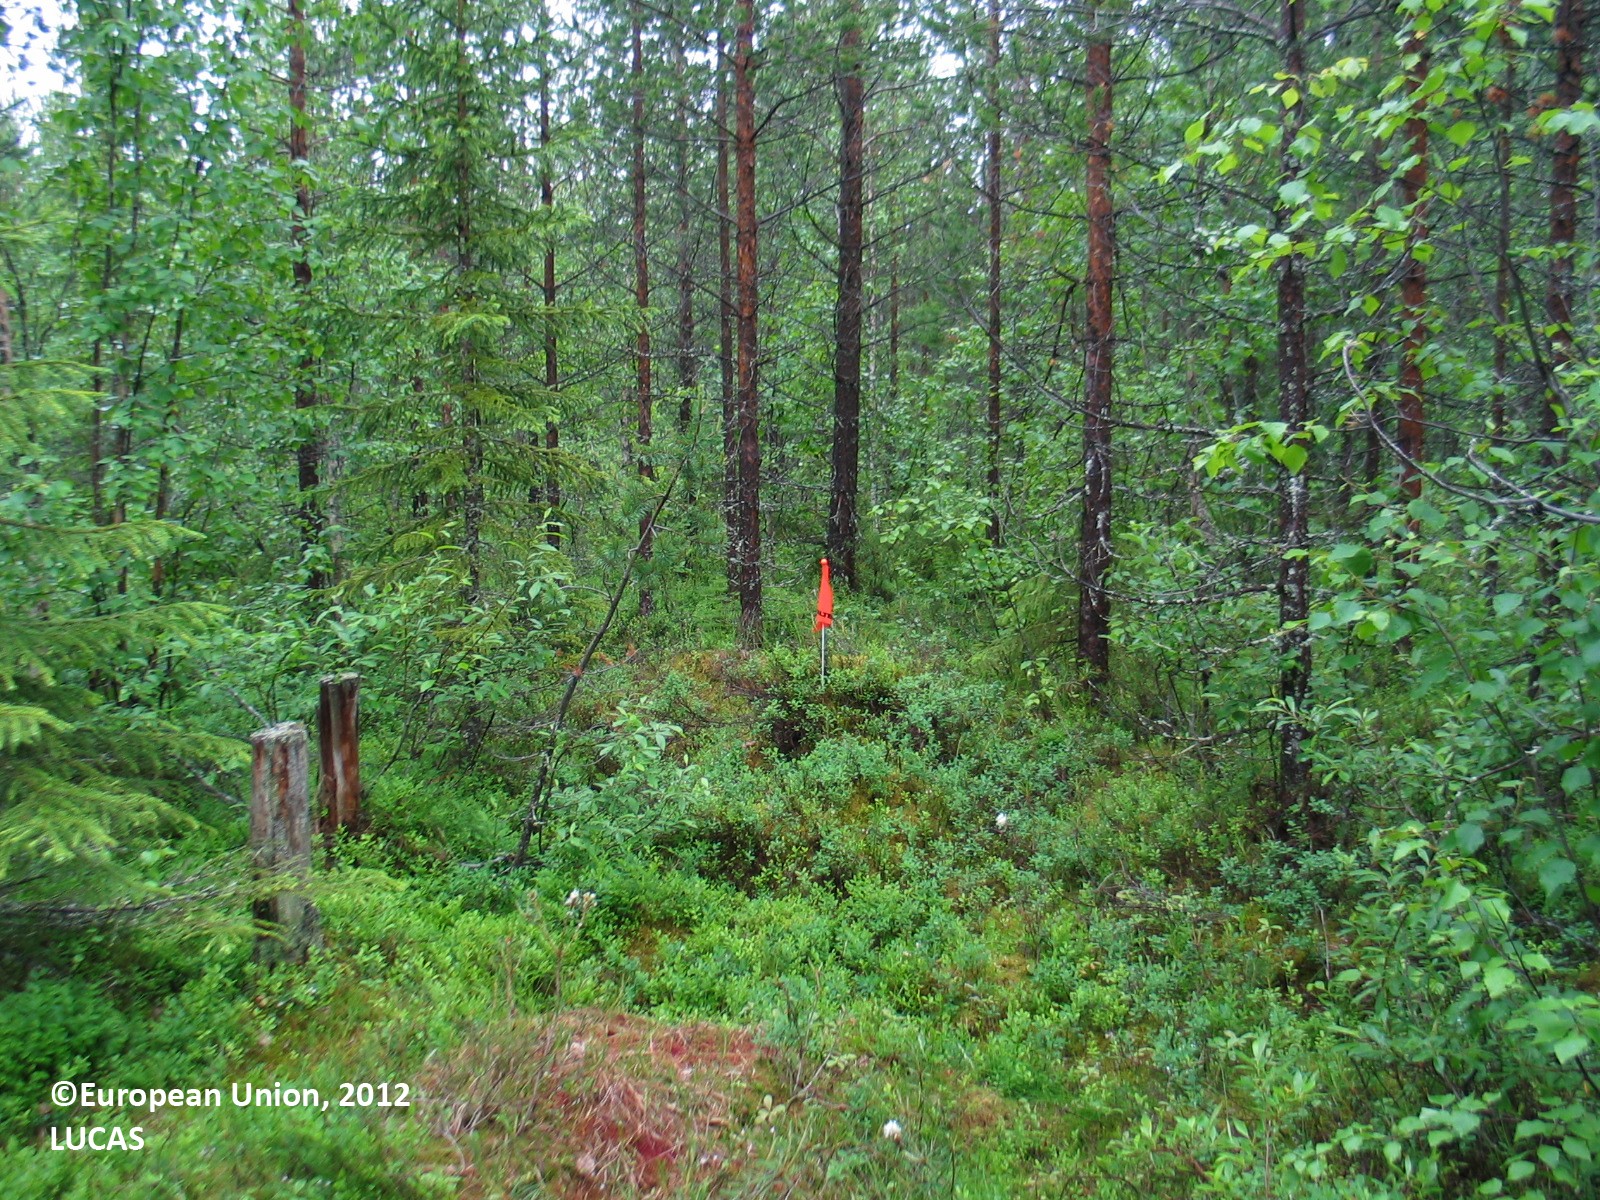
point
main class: Woodland
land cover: Pine dominated coniferous woodland
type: boreal forest
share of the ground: 25 - 50 %
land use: Forestry
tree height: > 5 m
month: July
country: FI
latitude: 66.0034
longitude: 25.2484
